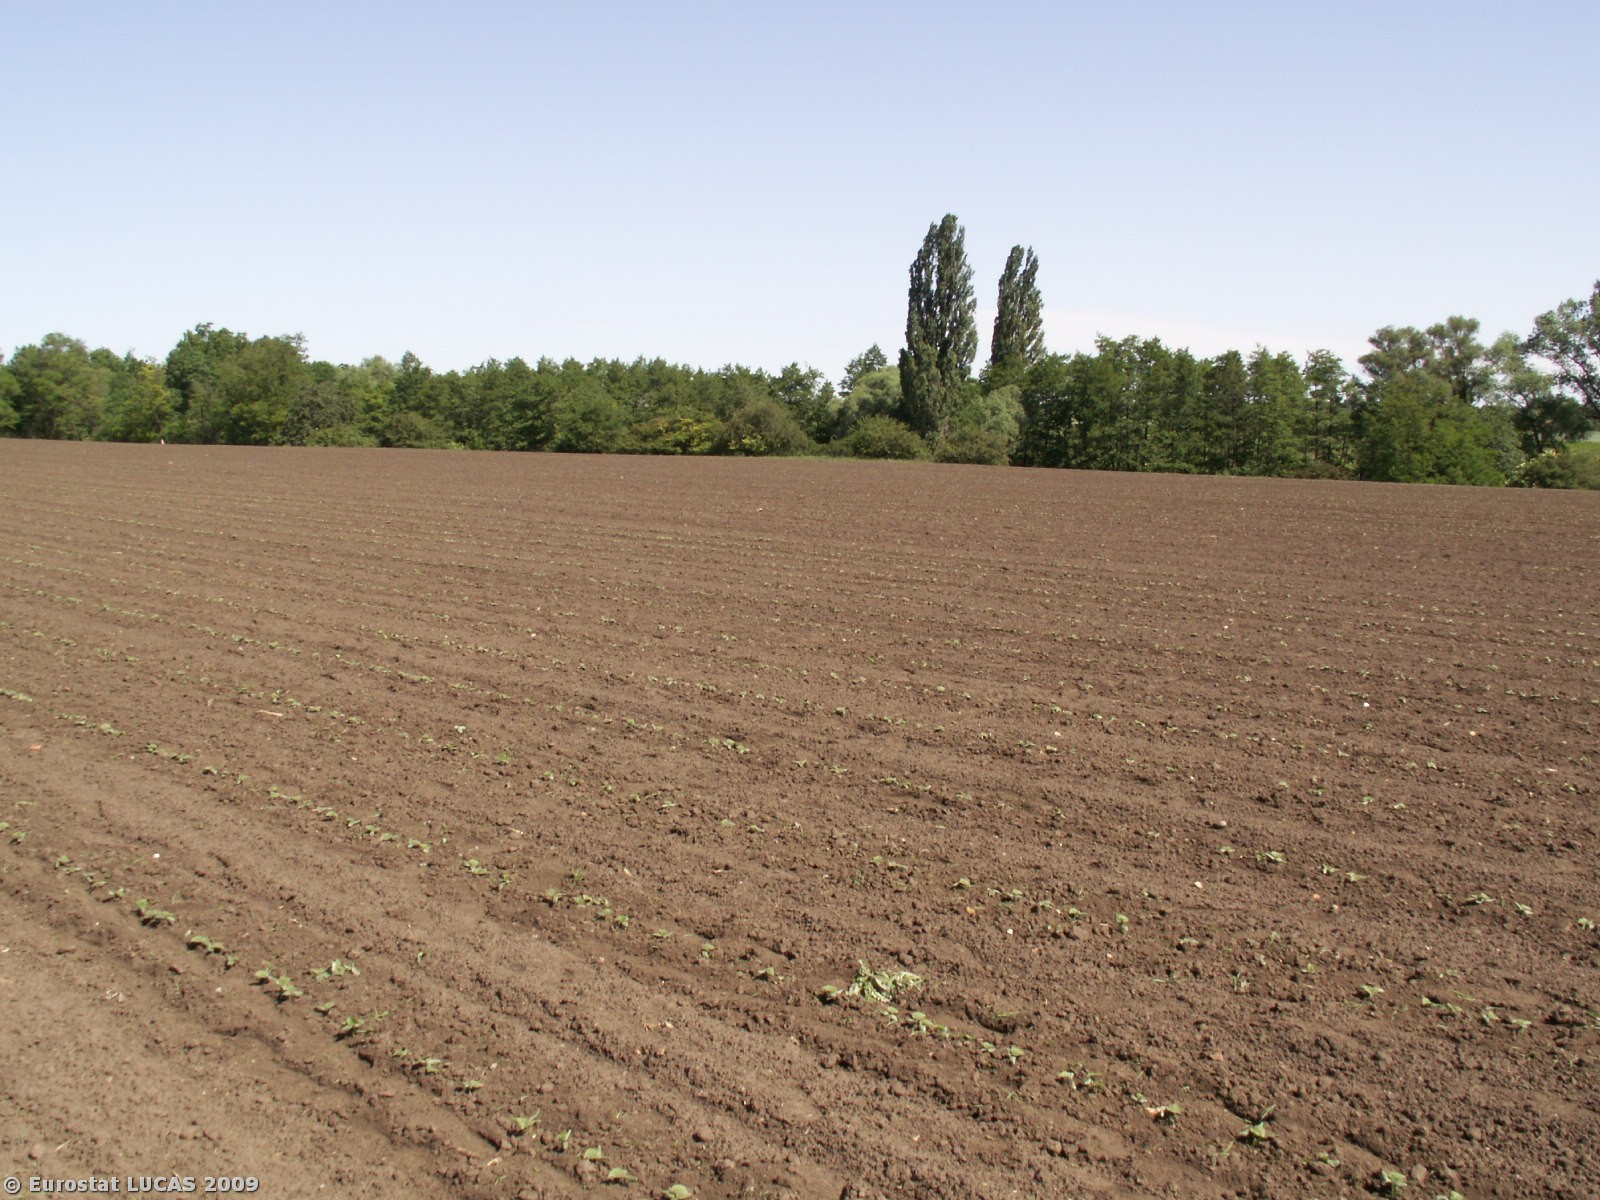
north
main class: Cropland
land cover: Other fresh vegetables
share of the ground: < 10 %
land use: Agriculture (excluding fallow land and kitchen gardens)
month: June
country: CZ
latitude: 48.8973
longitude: 16.5133
